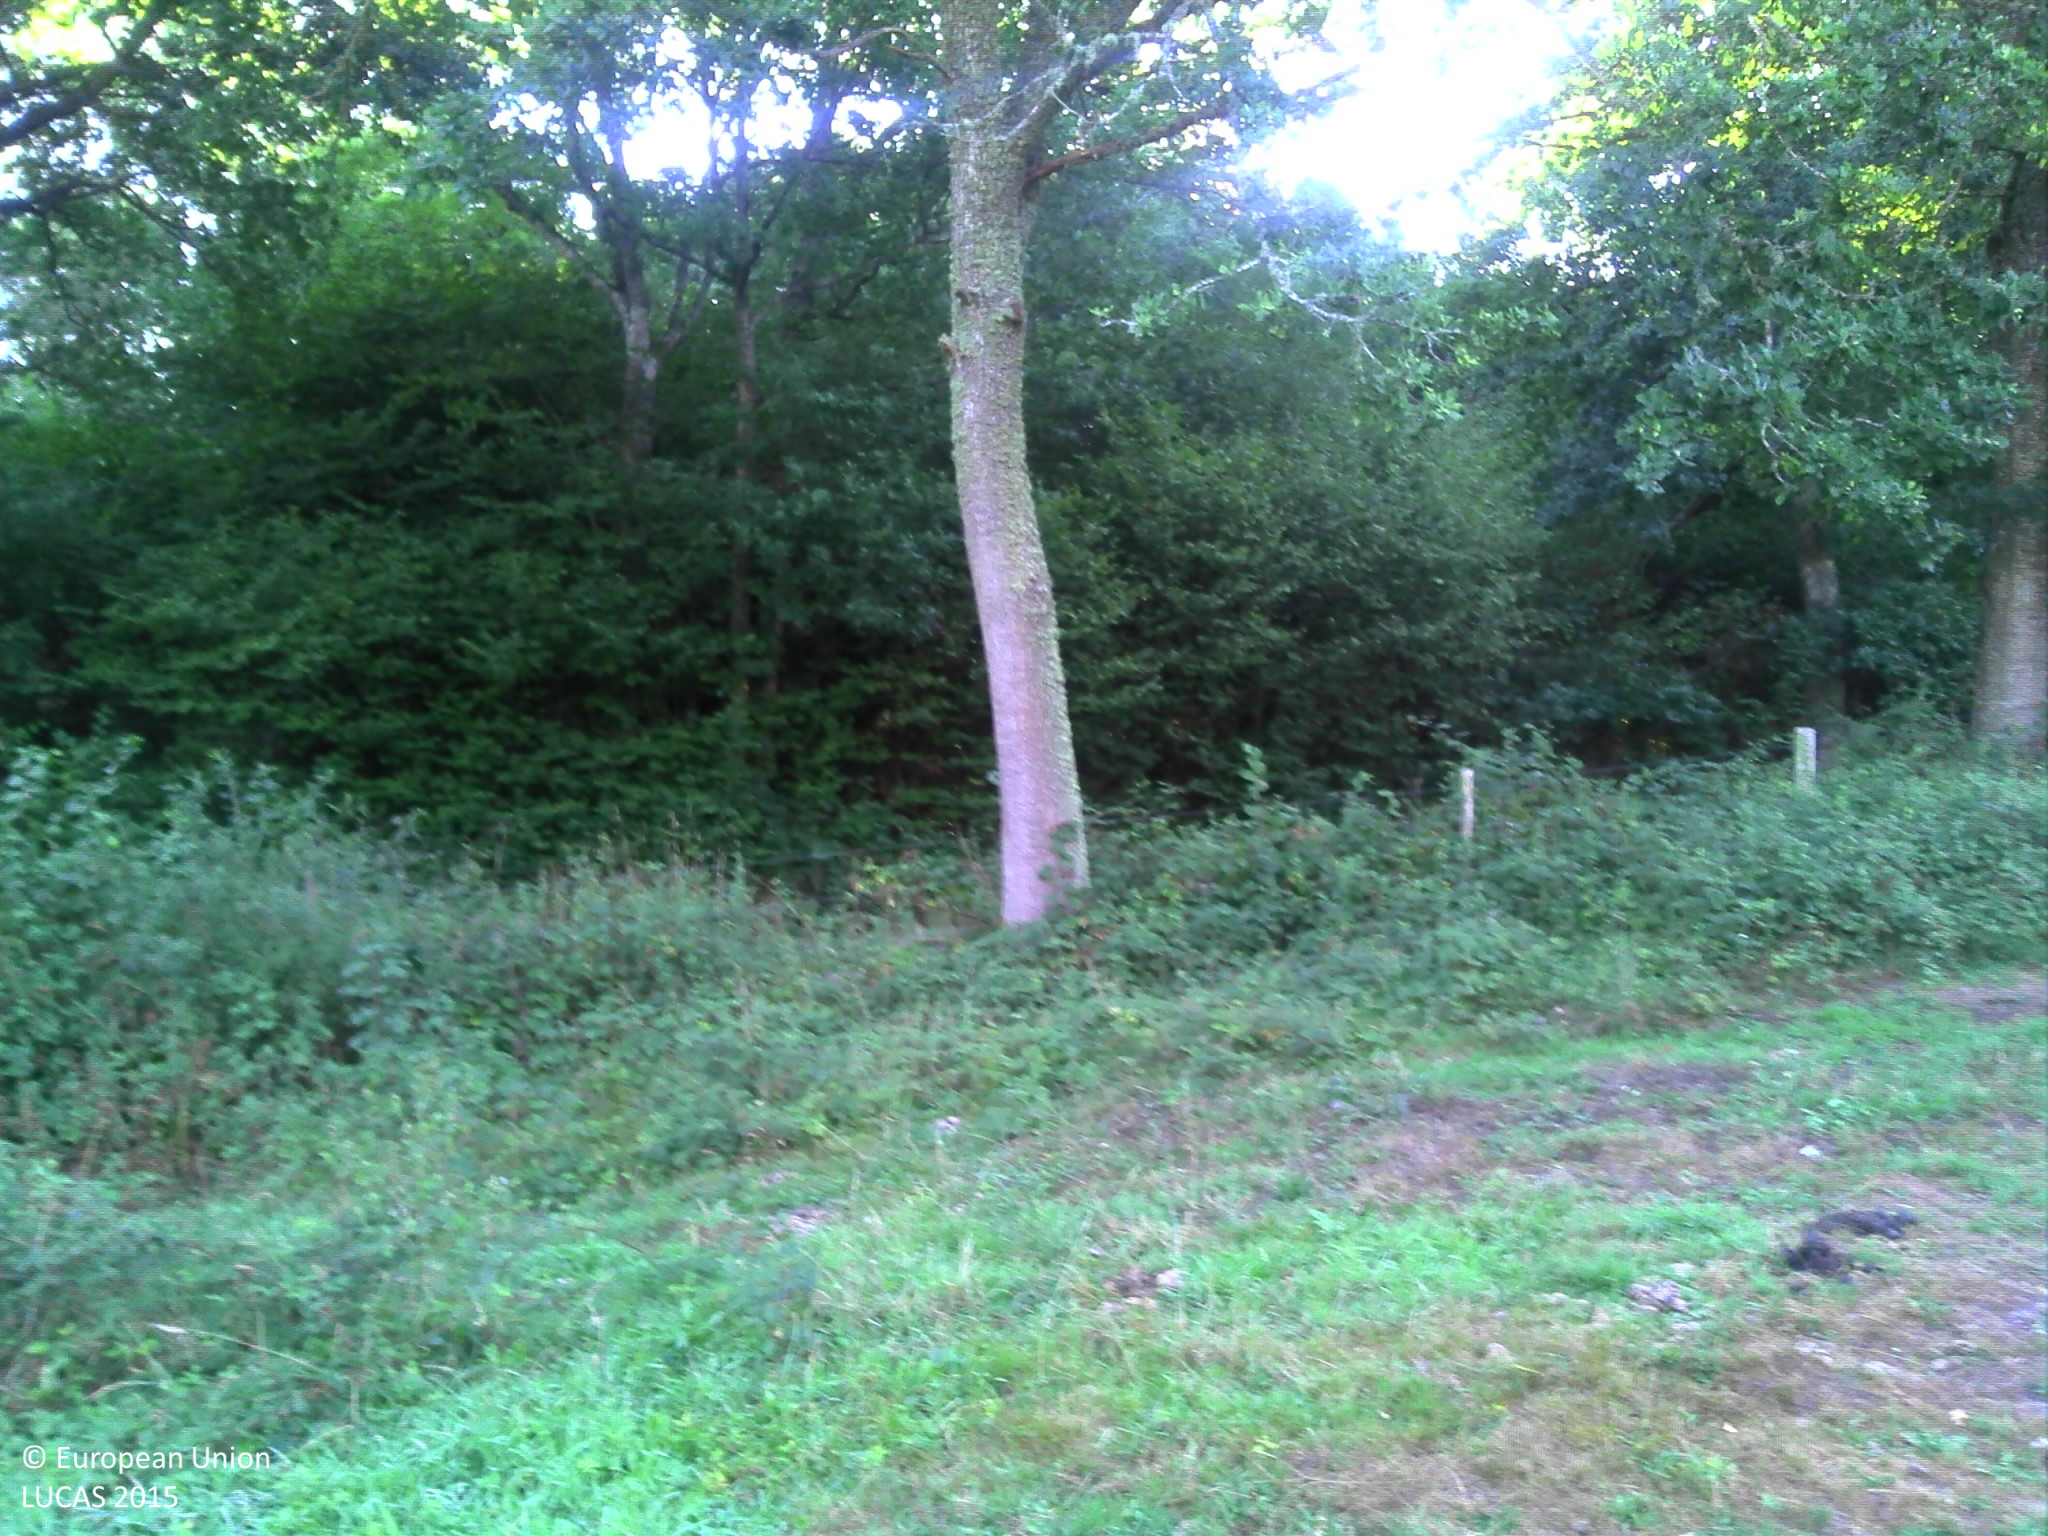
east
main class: Grassland
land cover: Grassland without tree/shrub cover
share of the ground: > 75 %
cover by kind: herbaceous plants 95 %, shrubs 5 %
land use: Agriculture (excluding fallow land and kitchen gardens)
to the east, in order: Grassland without tree/shrub cover; Single bushes/trees; Fences; Shruby margins; Grass margins; Paved roads, cycling and walking lanes; Grass margins; Ditches and canals; Broadleaved woodland; Ditches and canals; Broadleaved woodland; Fences; Grassland without tree/shrub cover; Fences; Broadleaved woodland
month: August
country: FR
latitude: 45.8426
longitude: 2.3612
